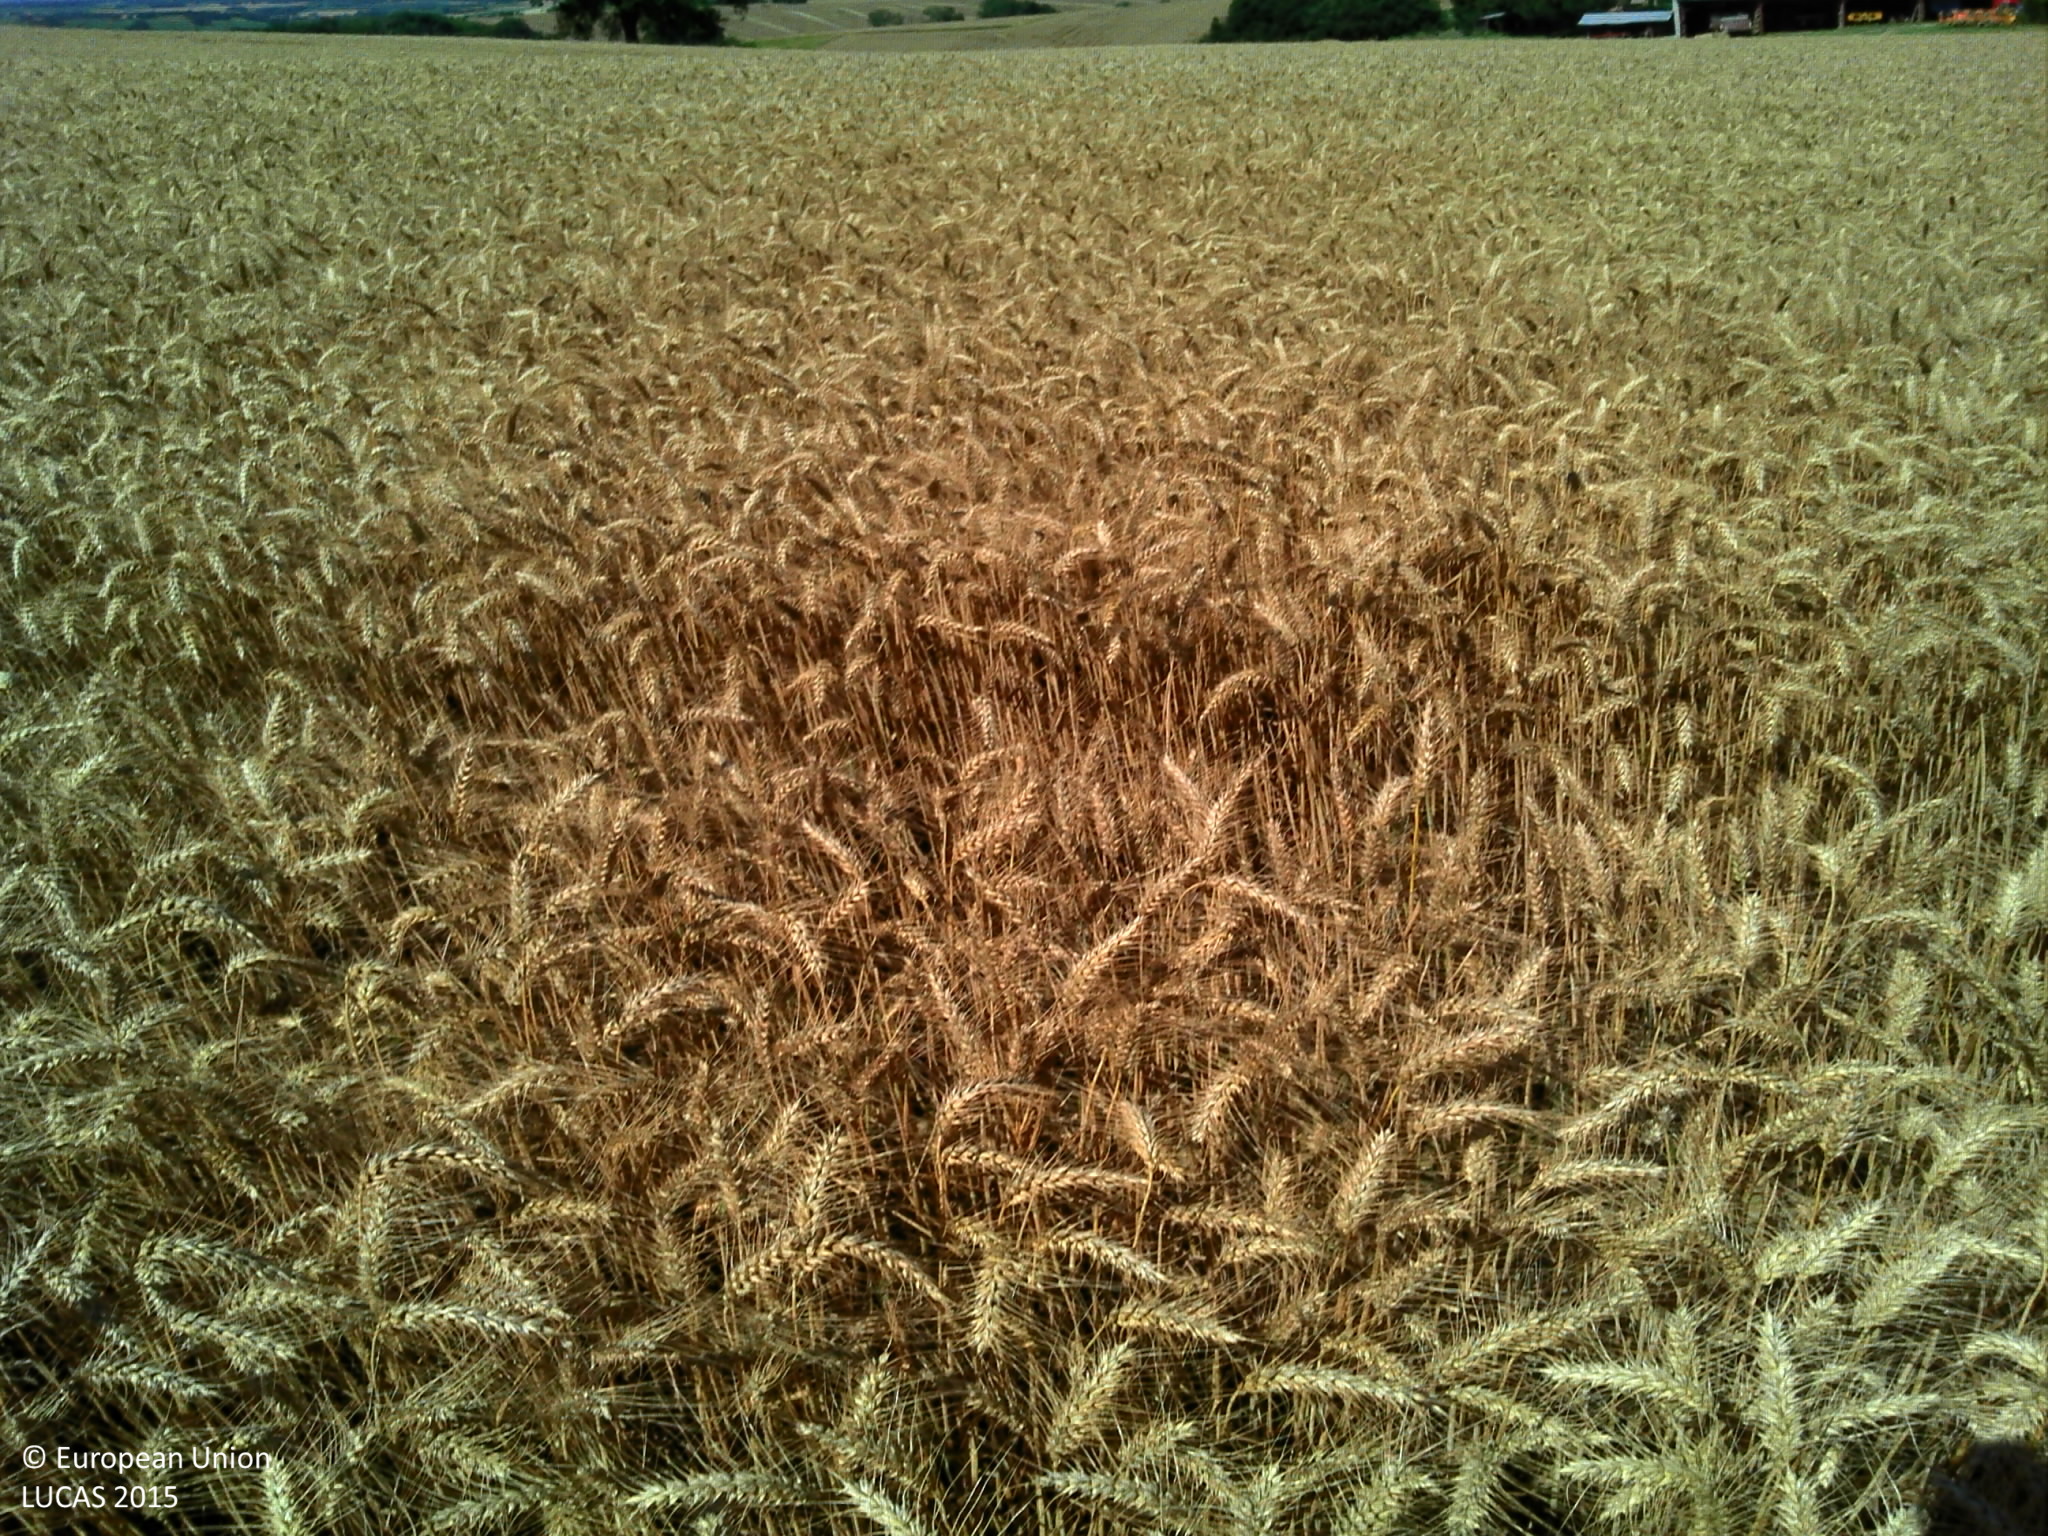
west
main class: Cropland
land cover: Common wheat
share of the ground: > 75 %
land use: Agriculture (excluding fallow land and kitchen gardens)
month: June
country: FR
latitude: 43.7788
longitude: 1.0163
